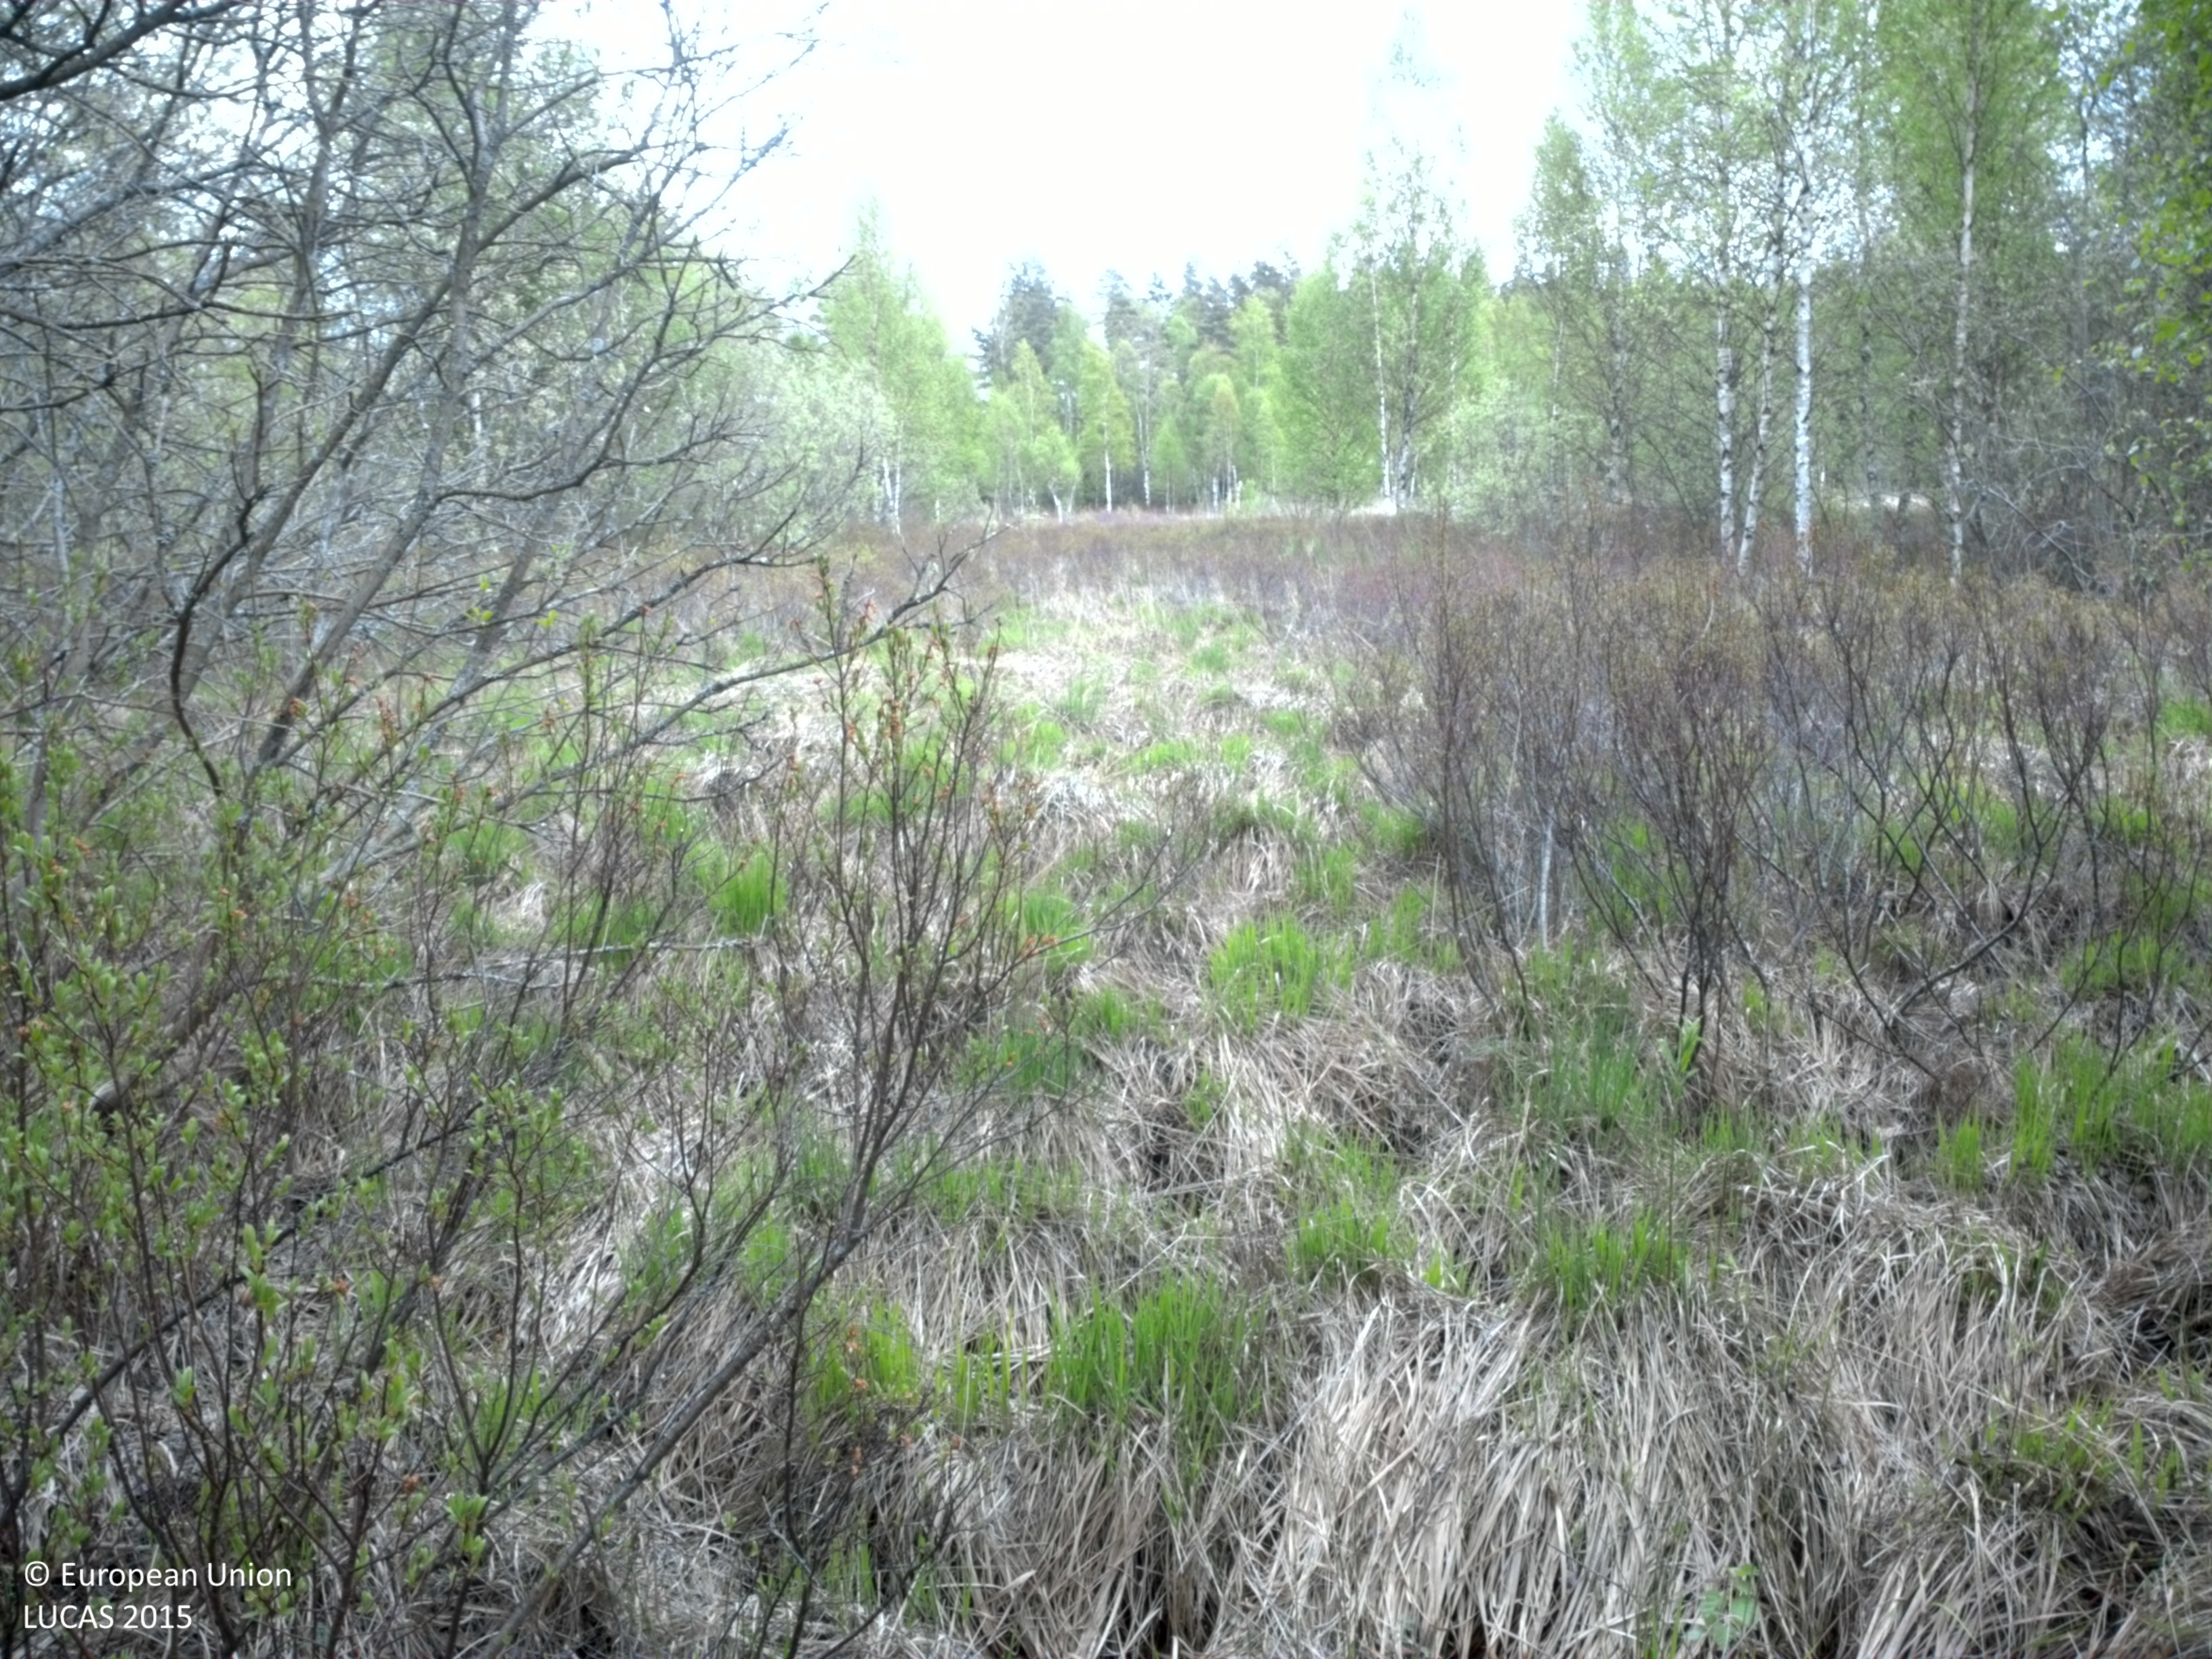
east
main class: Woodland
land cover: Broadleaved woodland
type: mire and swamp forests
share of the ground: > 75 %
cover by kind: broadleaved forest trees 75 %, herbaceous plants 25 %
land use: Semi-natural and natural areas not in use
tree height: > 5 m
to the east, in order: Broadleaved woodland; Shrubland with sparse tree cover; Broadleaved woodland; Inland marshes; Groves; Spruce dominated mixed woodland; Broadleaved woodland; Spruce dominated mixed woodland
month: May
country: SE
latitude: 56.6769
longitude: 15.2046
